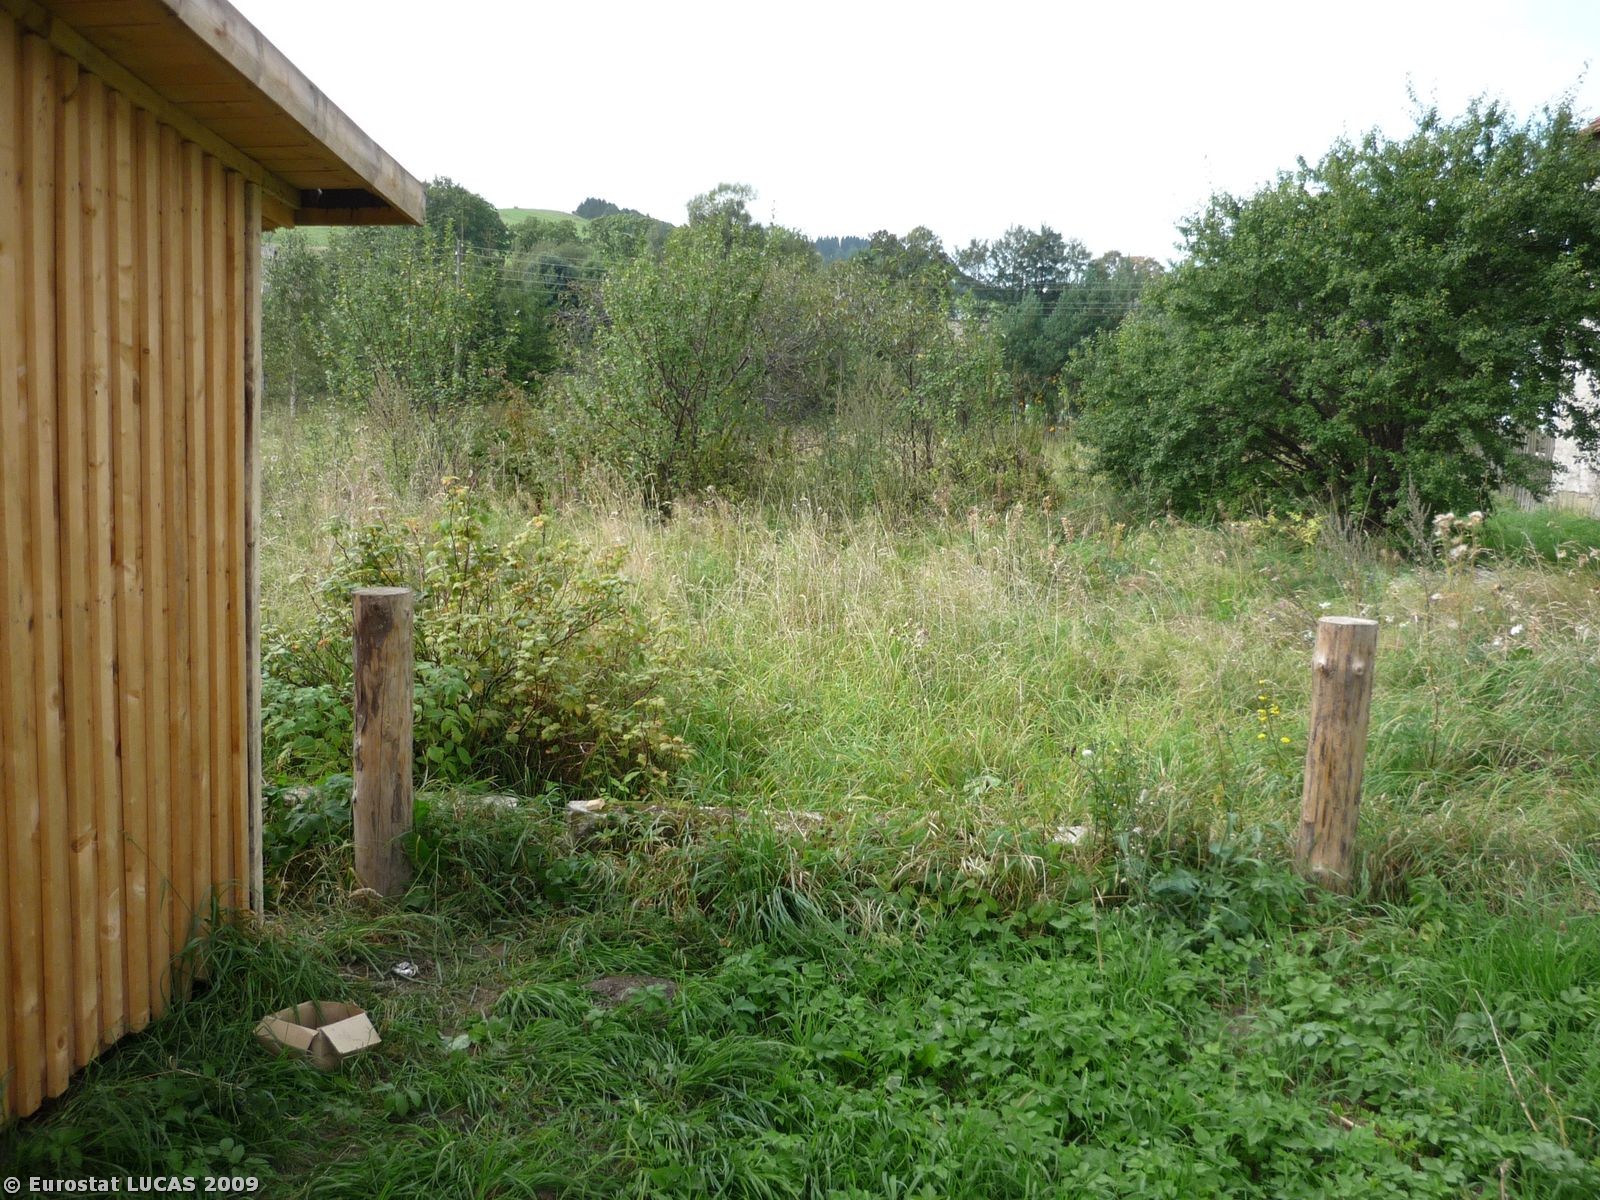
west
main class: Artificial land
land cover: Buildings with 1 to 3 floors
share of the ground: 50 - 75 %
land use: Residential
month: September
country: PL
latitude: 50.7579
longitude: 16.1445
